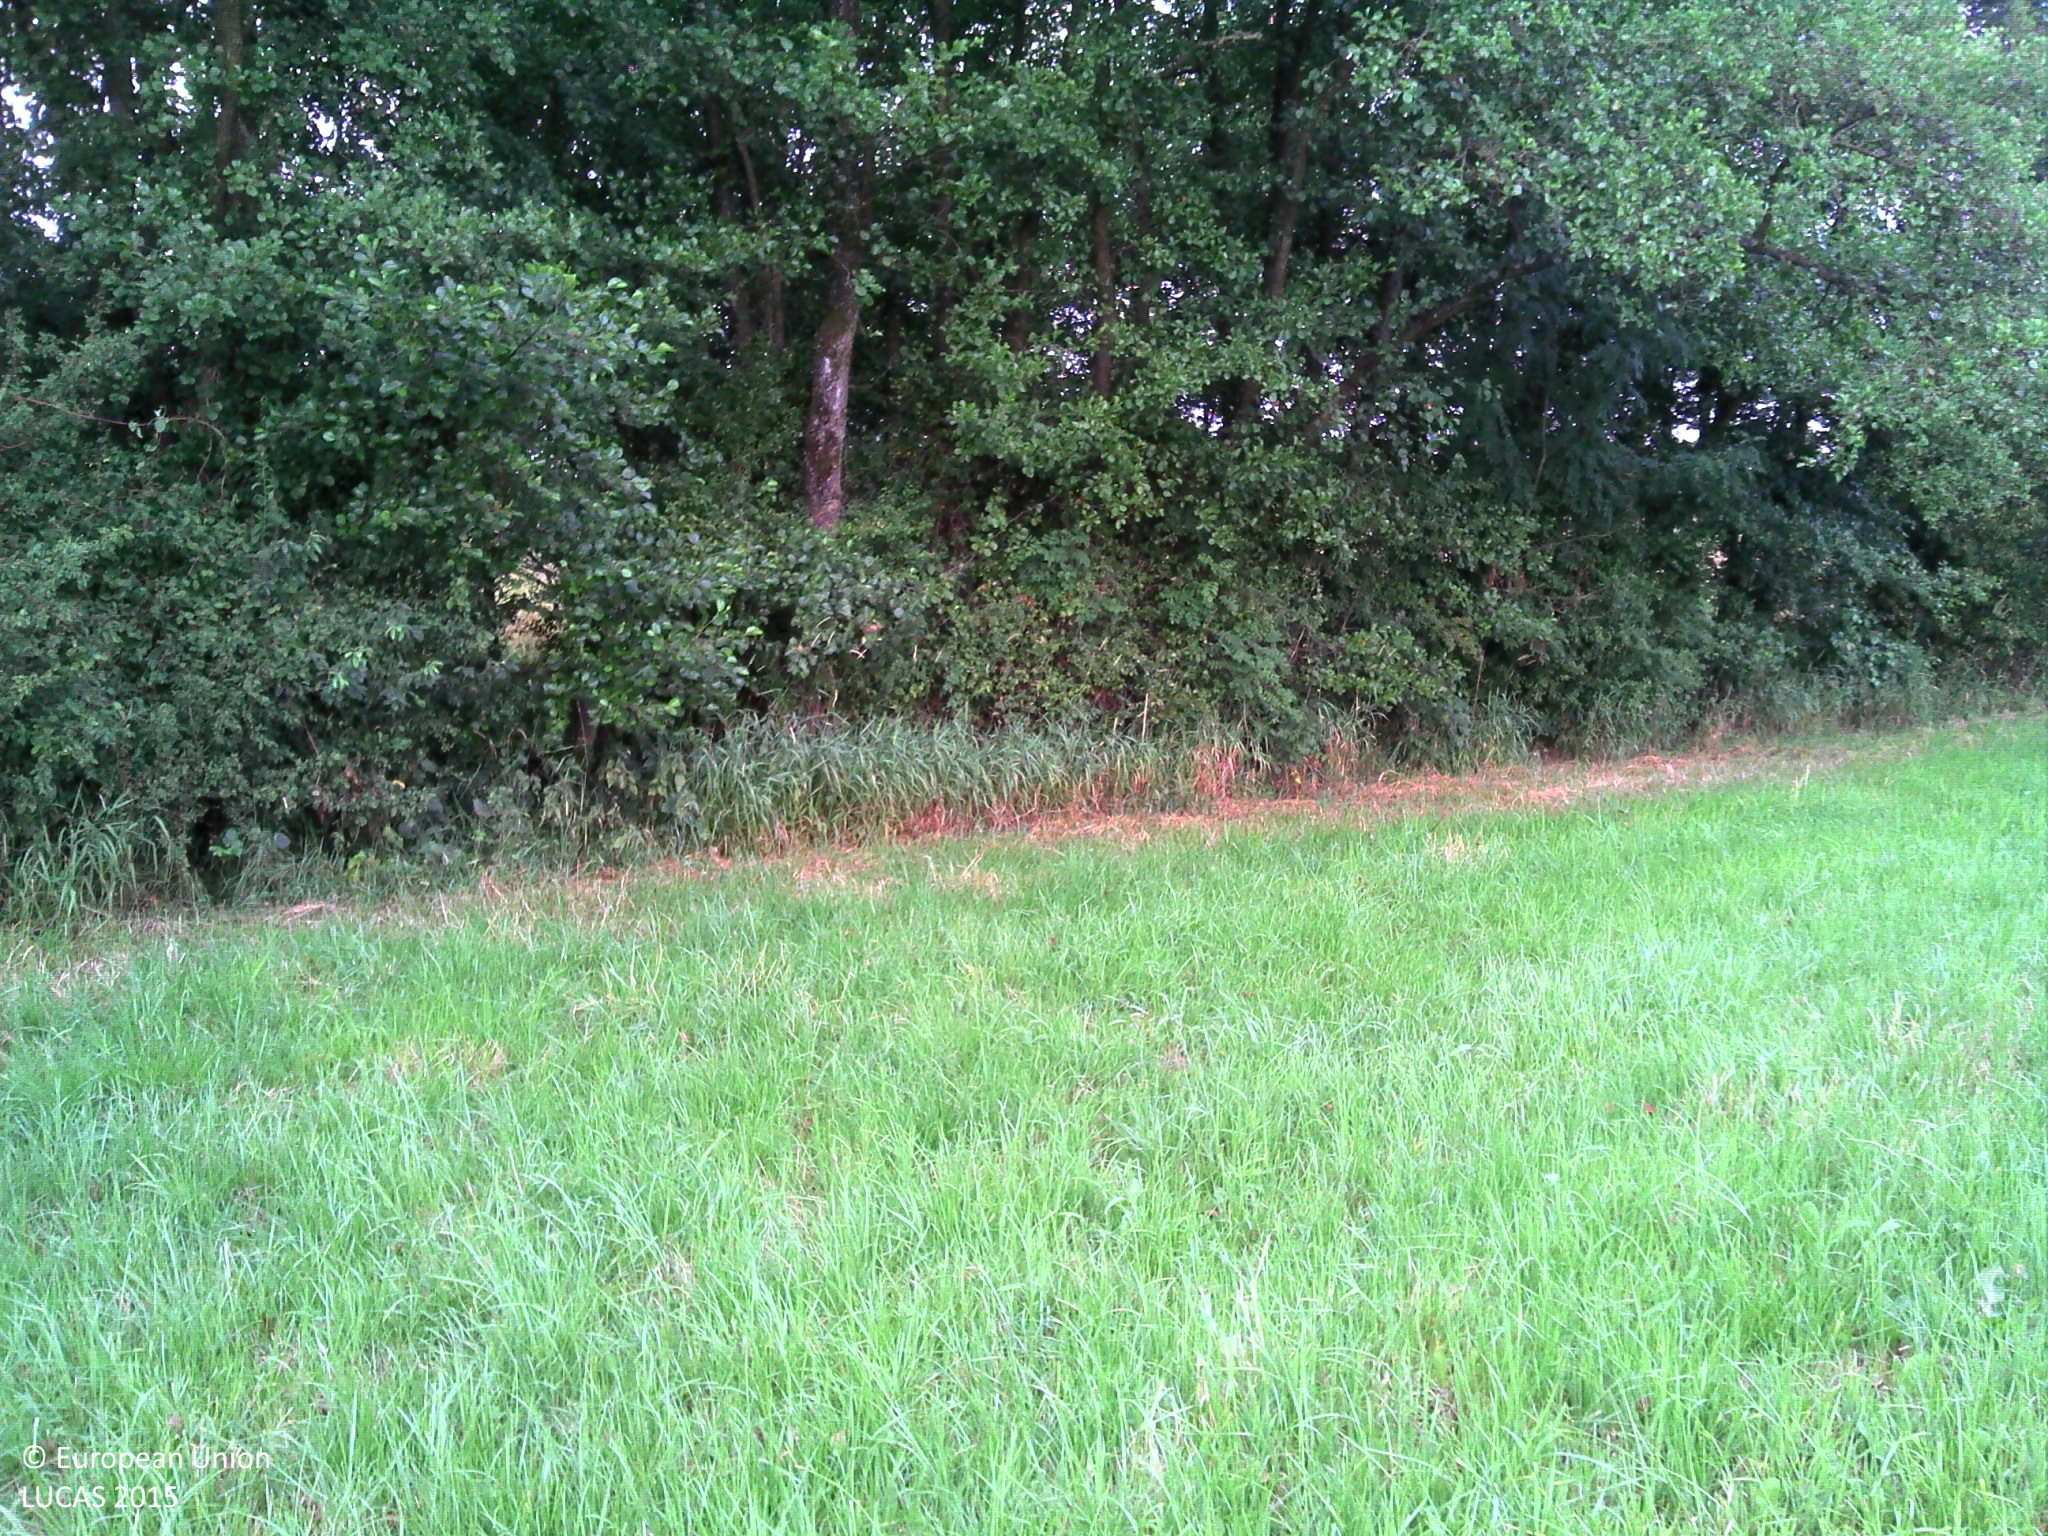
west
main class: Grassland
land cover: Grassland without tree/shrub cover
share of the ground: > 75 %
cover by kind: herbaceous plants 100 %
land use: Agriculture (excluding fallow land and kitchen gardens)
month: July
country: BE
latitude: 49.6885
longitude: 5.6878
